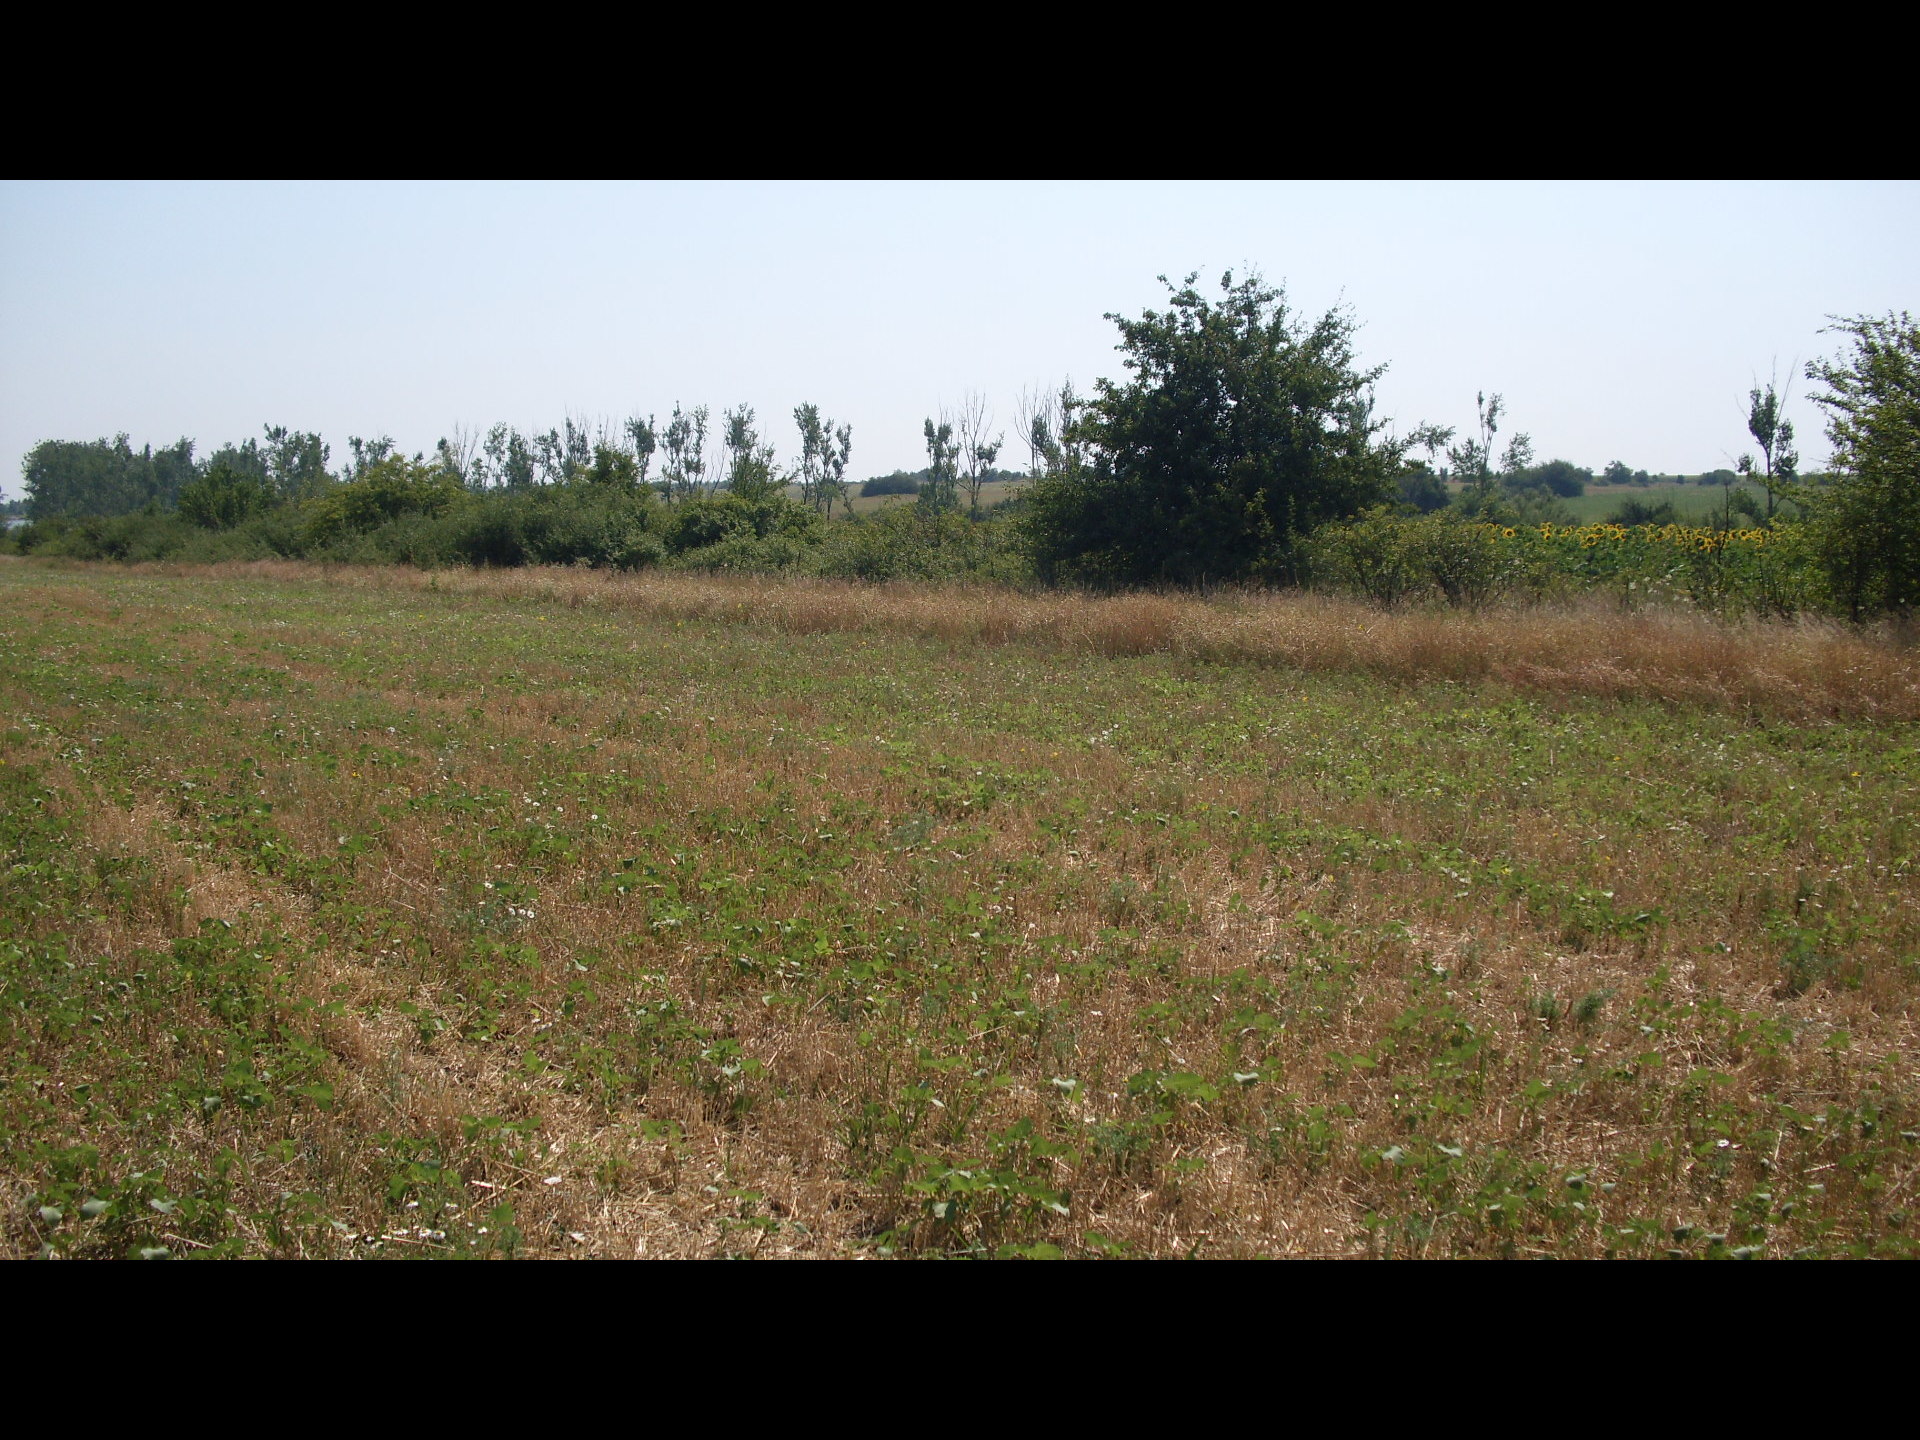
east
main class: Cropland
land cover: Common wheat
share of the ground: 50 - 75 %
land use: Agriculture (excluding fallow land and kitchen gardens)
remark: Harvested field
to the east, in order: Common wheat; Abandoned hedges; Ditches and canals; Abandoned hedges; Tracks; Sunflower
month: July
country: BG
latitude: 43.8097
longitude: 22.6527
